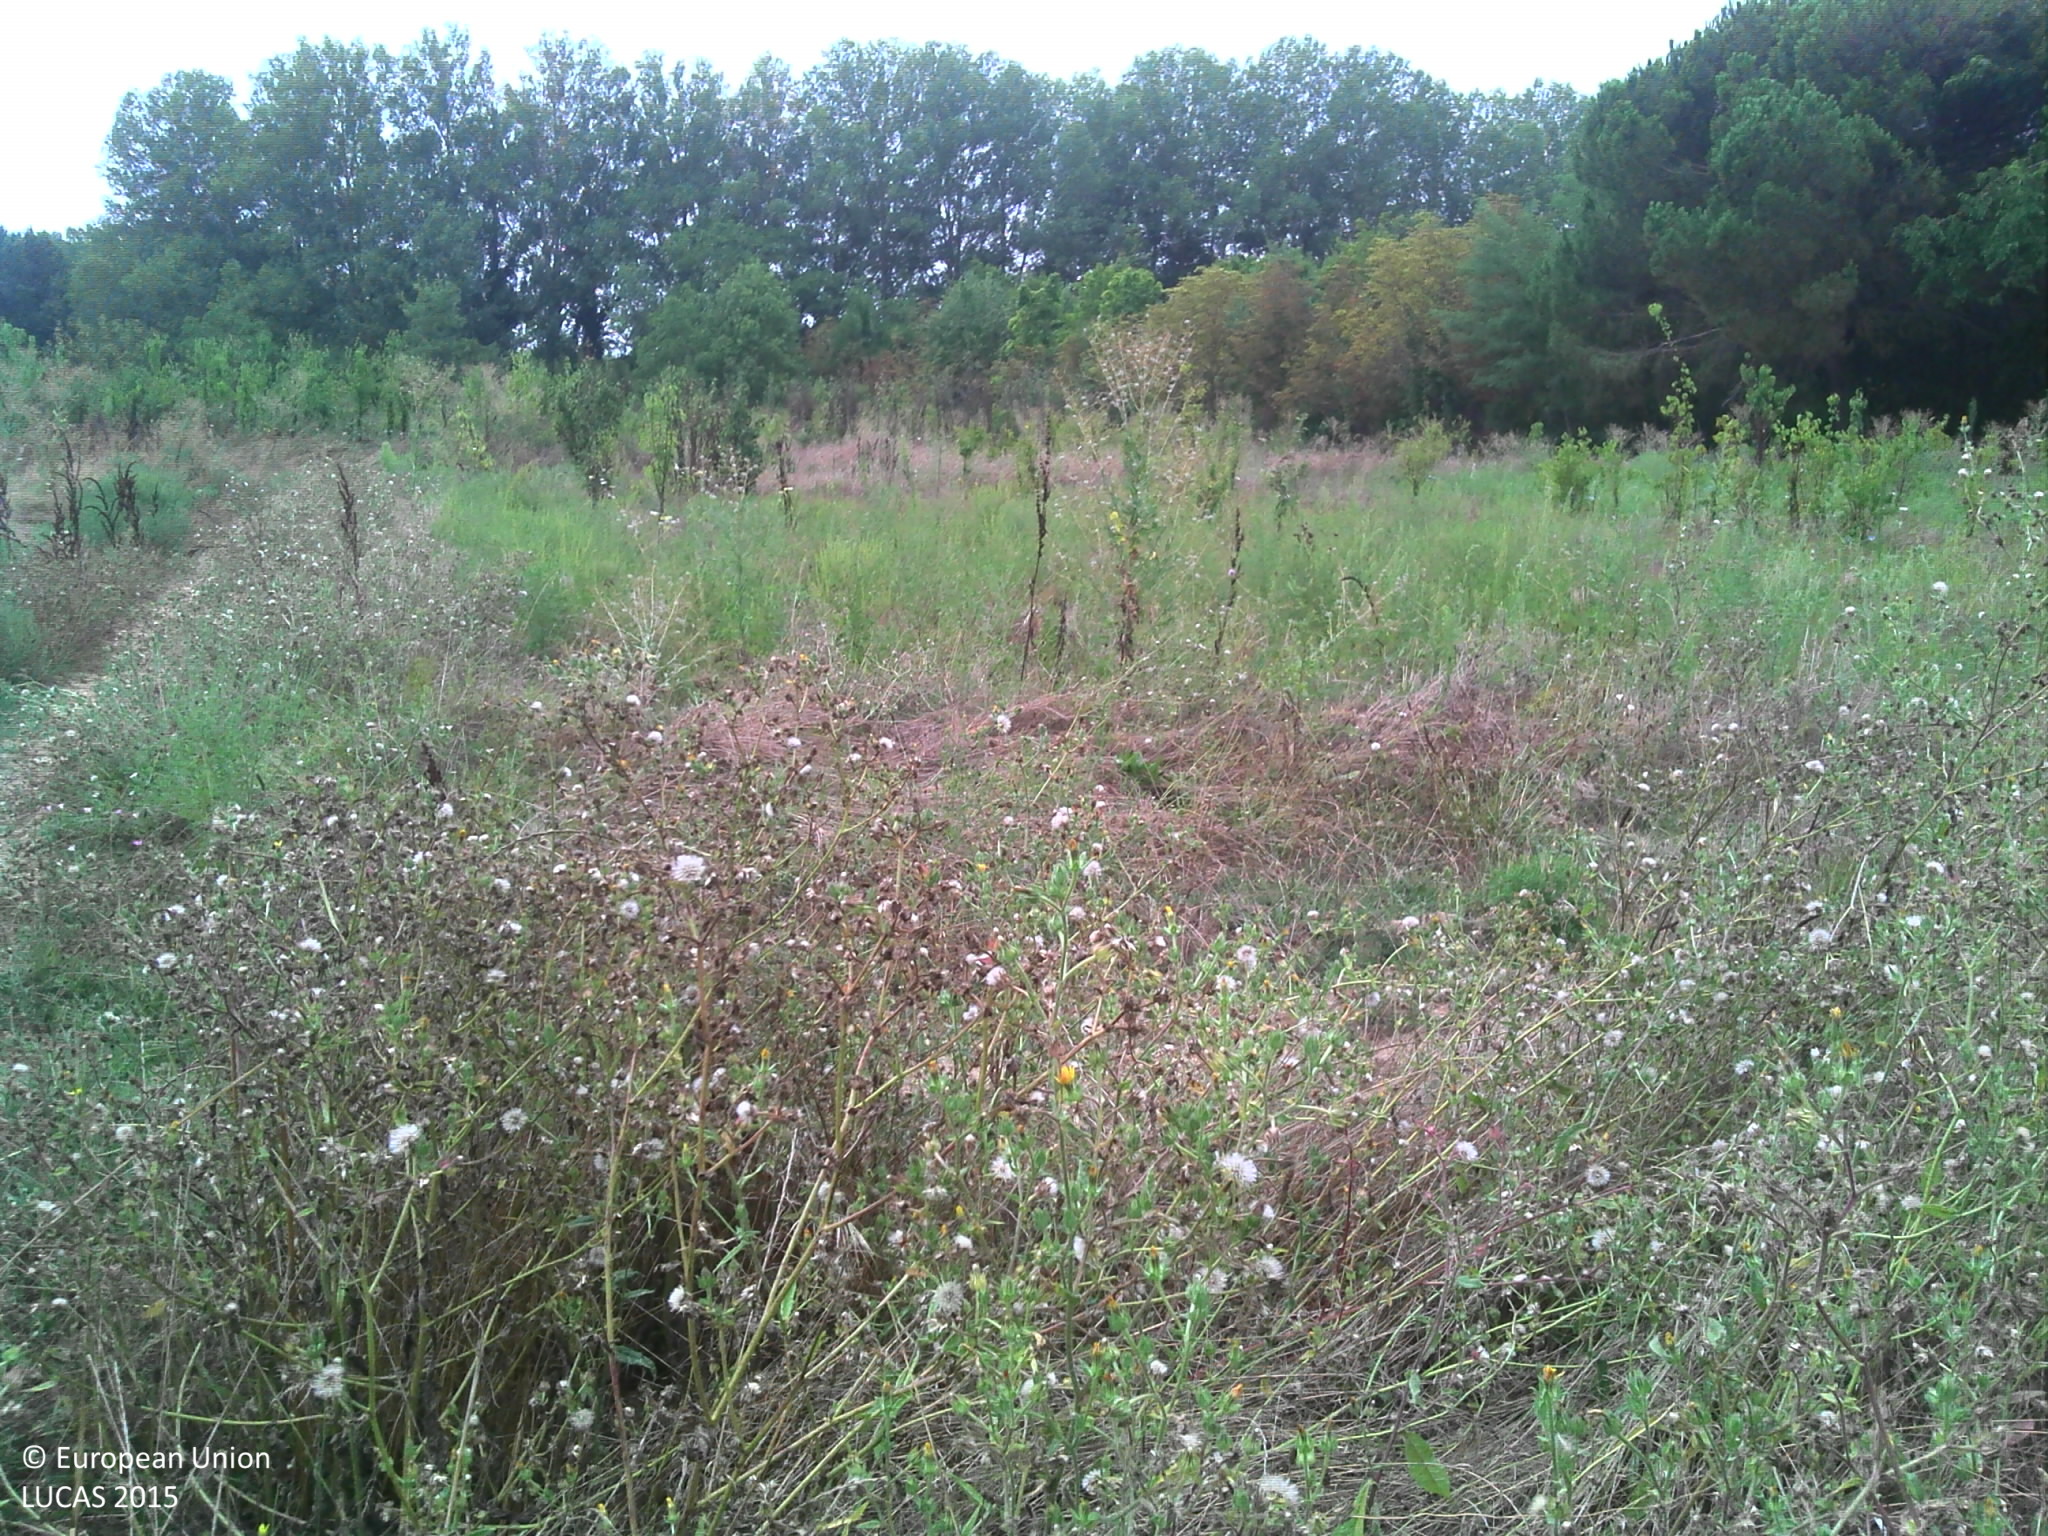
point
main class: Grassland
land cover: Spontaneously vegetated surfaces
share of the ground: > 75 %
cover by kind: herbaceous plants 100 %
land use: Fallow land
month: August
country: FR
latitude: 43.9359
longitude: 1.3674
